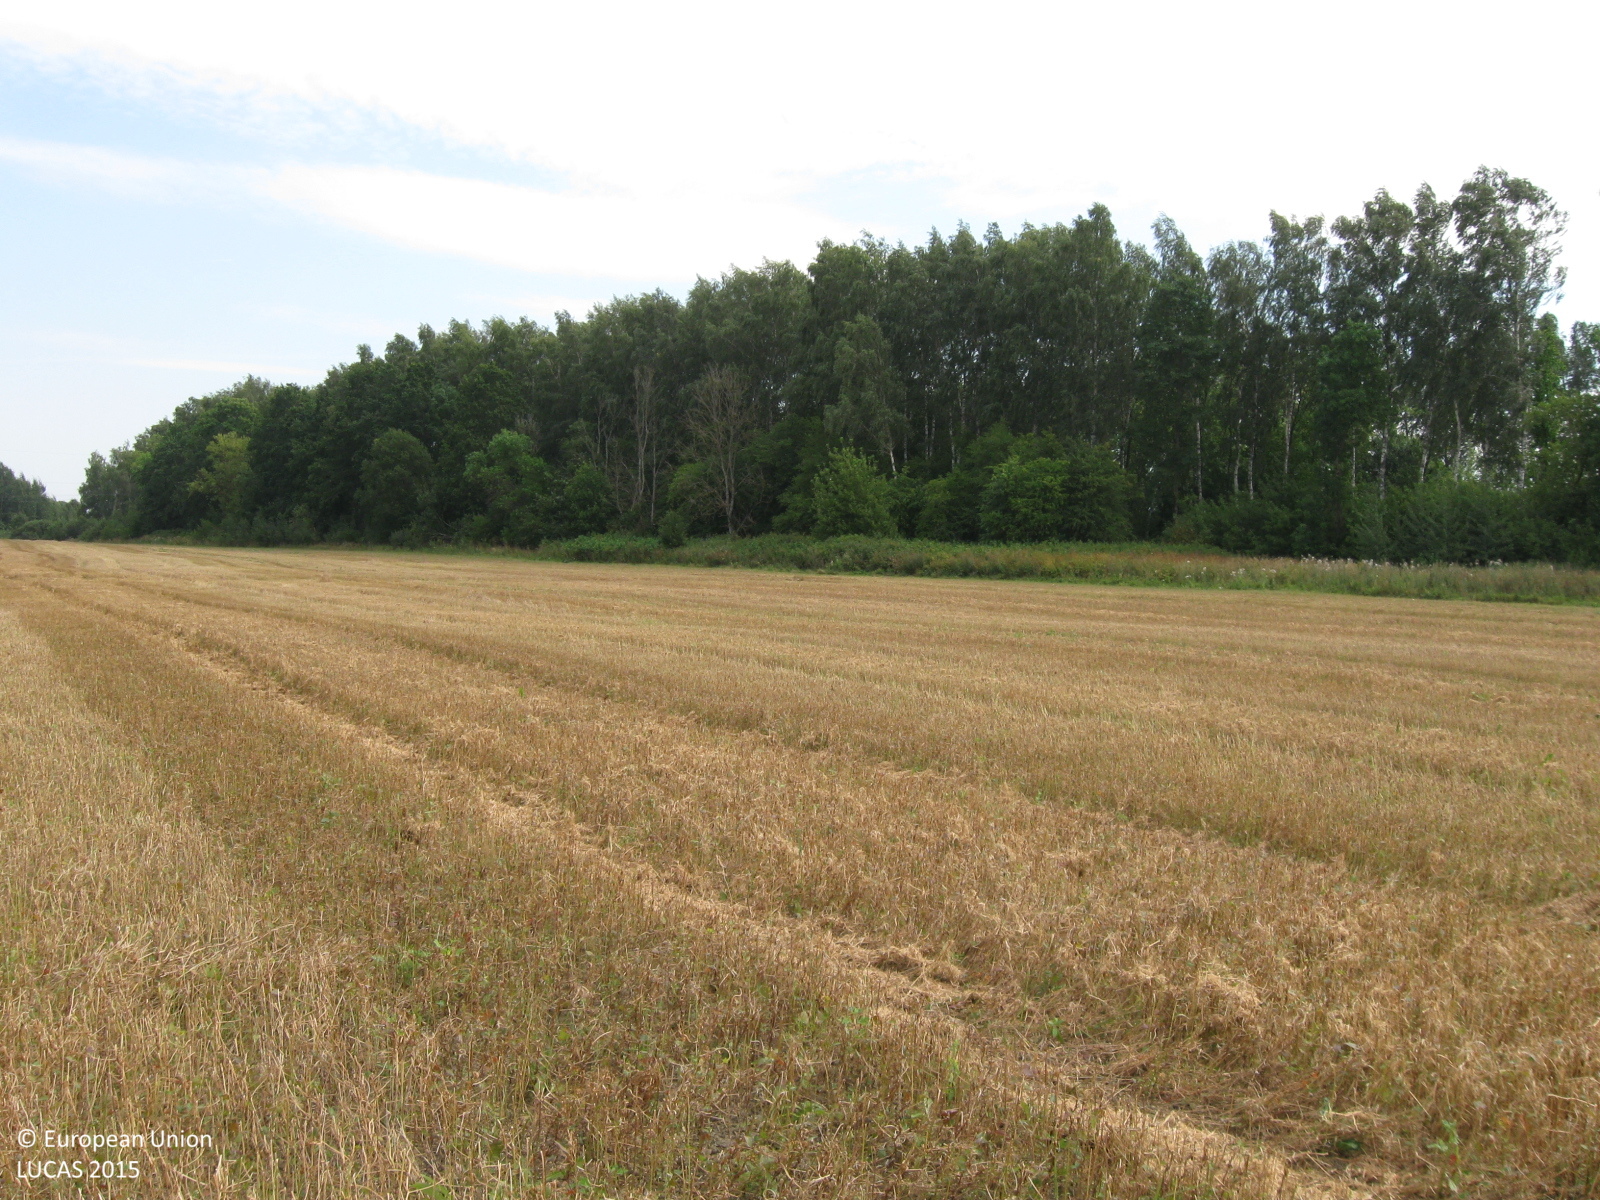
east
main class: Cropland
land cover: Dry pulses
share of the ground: > 75 %
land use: Agriculture (excluding fallow land and kitchen gardens)
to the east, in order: Dry pulses; Spontaneously vegetated surfaces; Broadleaved woodland; Spontaneously vegetated surfaces; Railways; Spontaneously vegetated surfaces; Electric lines; Spontaneously vegetated surfaces; Broadleaved woodland
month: August
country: LT
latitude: 55.4688
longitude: 22.9931
